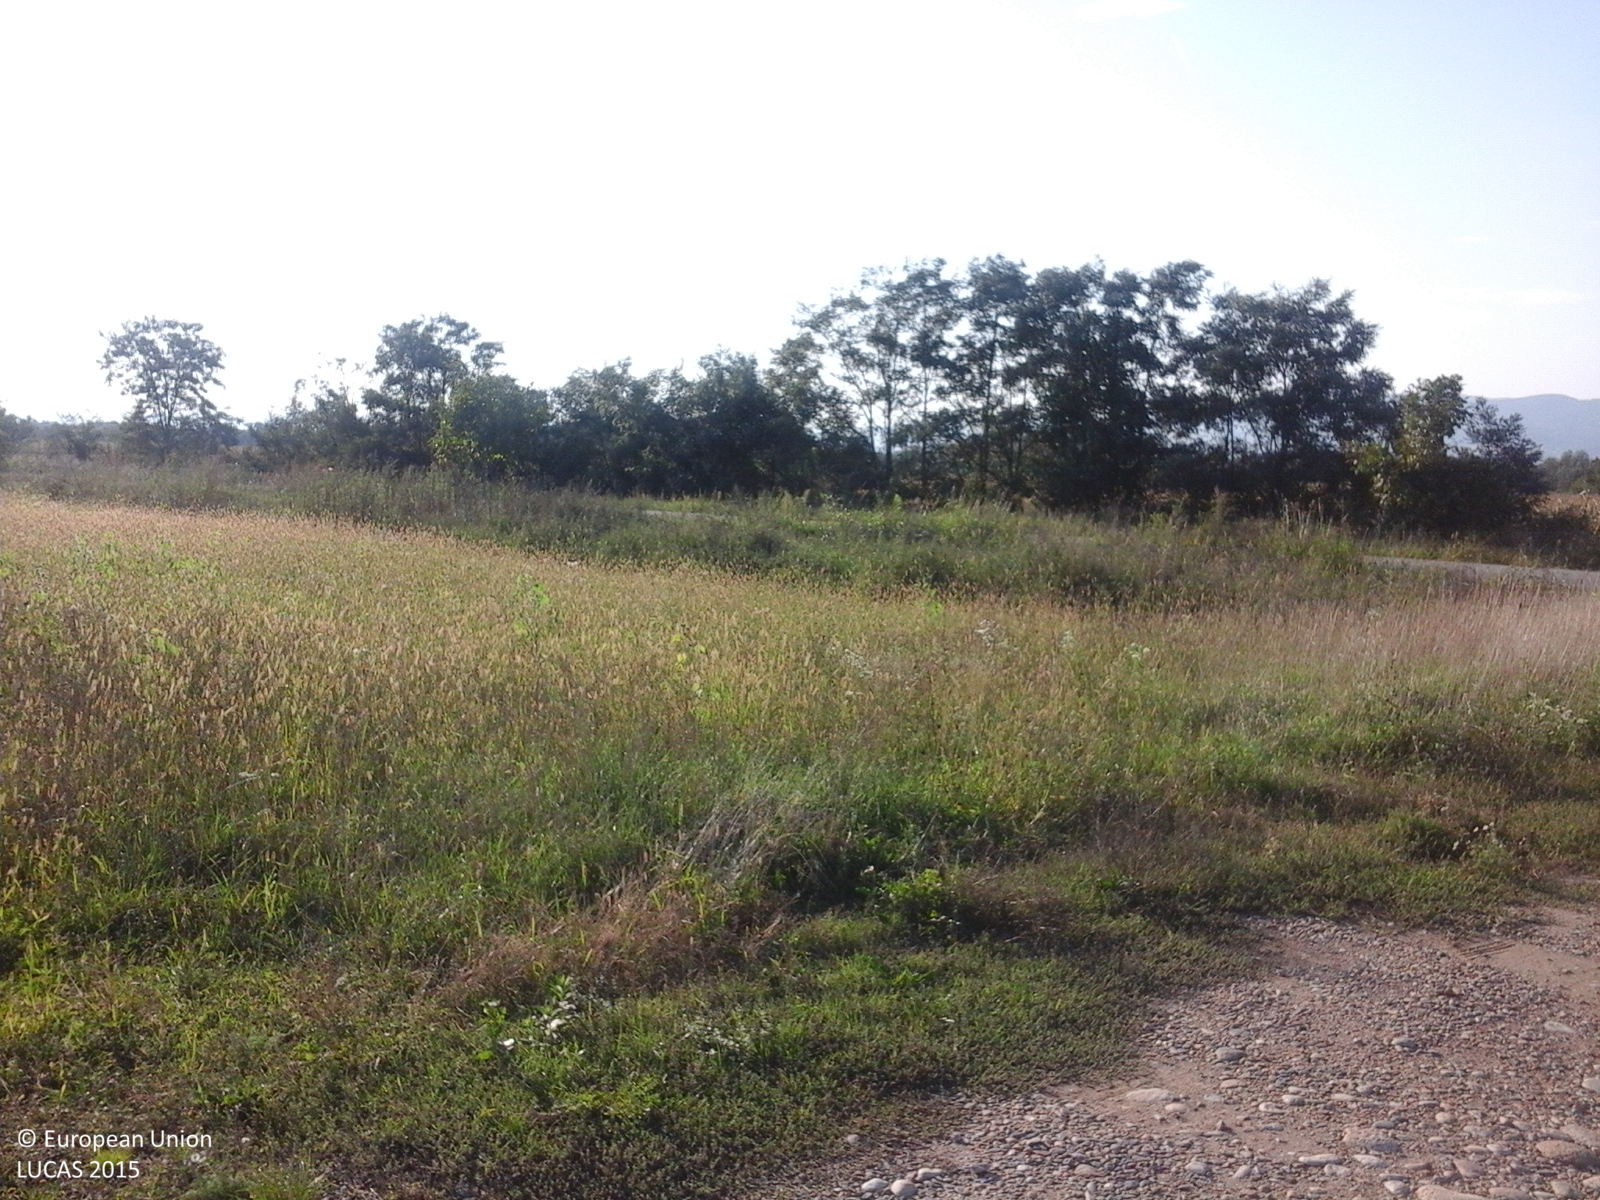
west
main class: Grassland
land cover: Spontaneously vegetated surfaces
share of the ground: > 75 %
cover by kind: herbaceous plants 100 %
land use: Fallow land
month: September
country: RO
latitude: 45.5774
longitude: 22.9576
